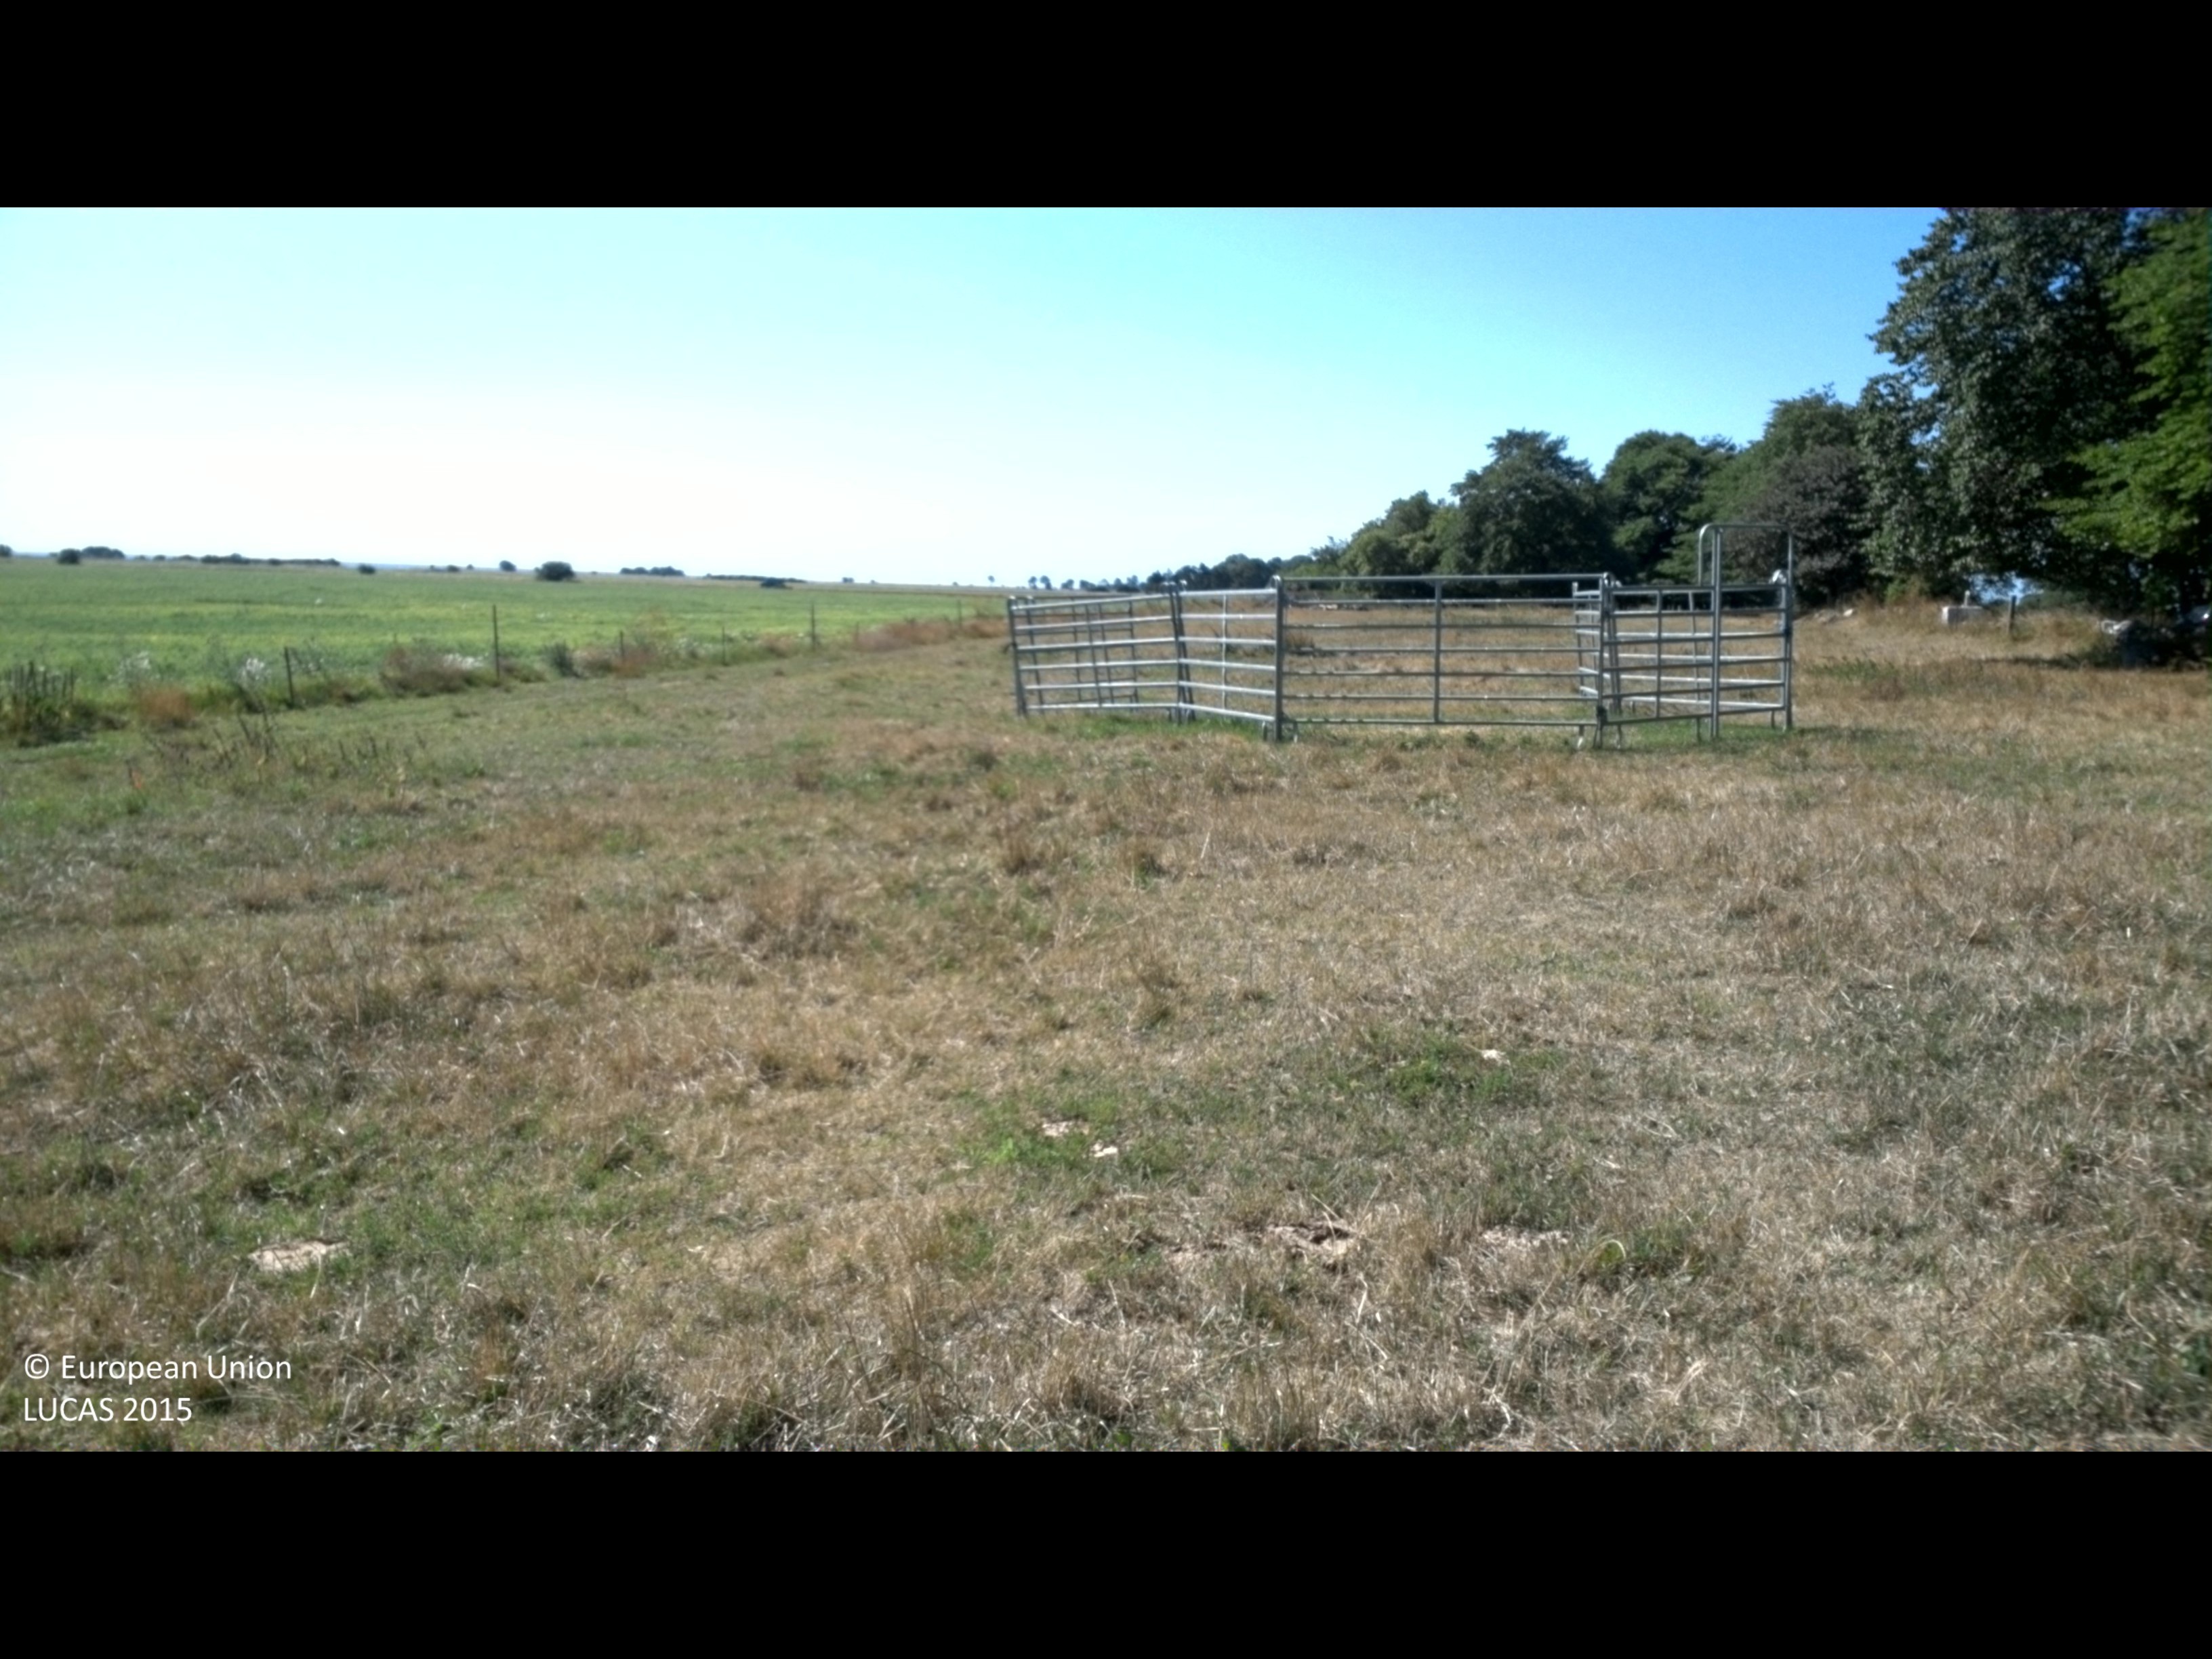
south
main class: Grassland
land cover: Grassland without tree/shrub cover
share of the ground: > 75 %
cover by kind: herbaceous plants 100 %
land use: Agriculture (excluding fallow land and kitchen gardens)
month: July
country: SE
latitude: 56.2588
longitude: 16.4756
